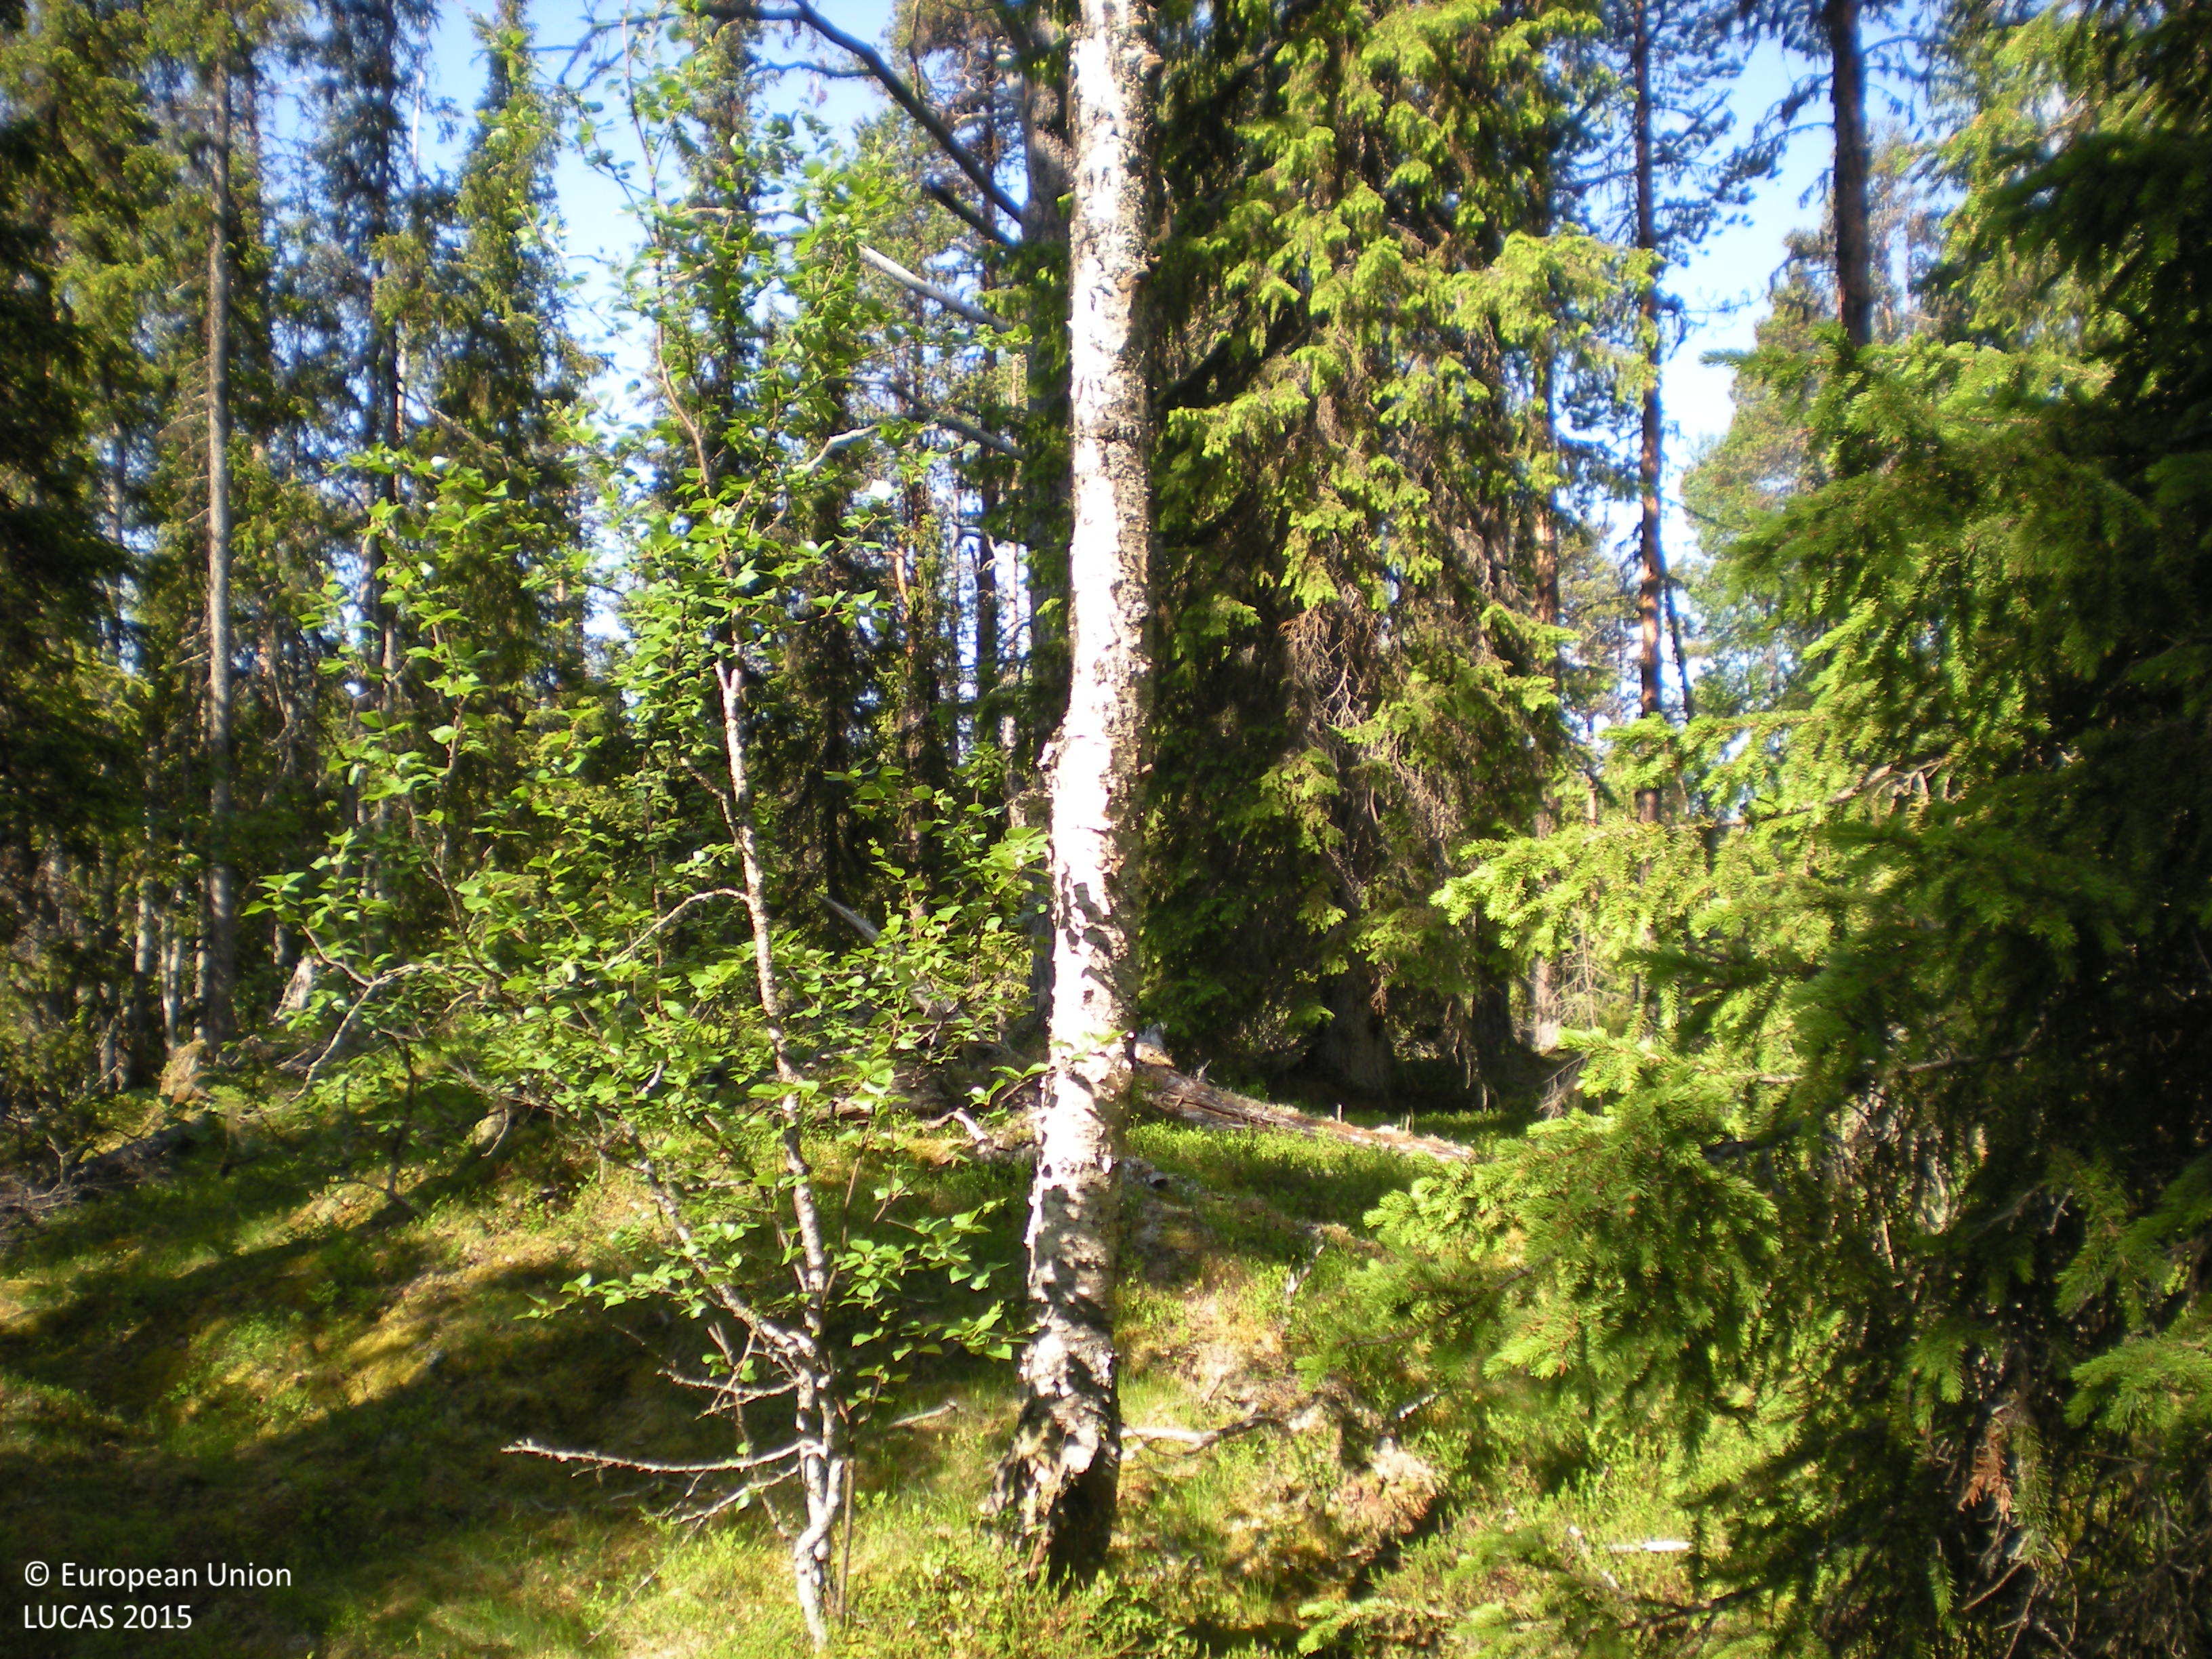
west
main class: Woodland
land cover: Spruce dominated mixed woodland
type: boreal forest
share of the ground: 50 - 75 %
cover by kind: coniferous forest trees 55 %, broadleaved forest trees 20 %, shrubs 10 %, lichens and mosses 10 %, herbaceous plants 5 %
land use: Semi-natural and natural areas not in use
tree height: > 5 m
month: July
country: SE
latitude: 65.6466
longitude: 16.4154
